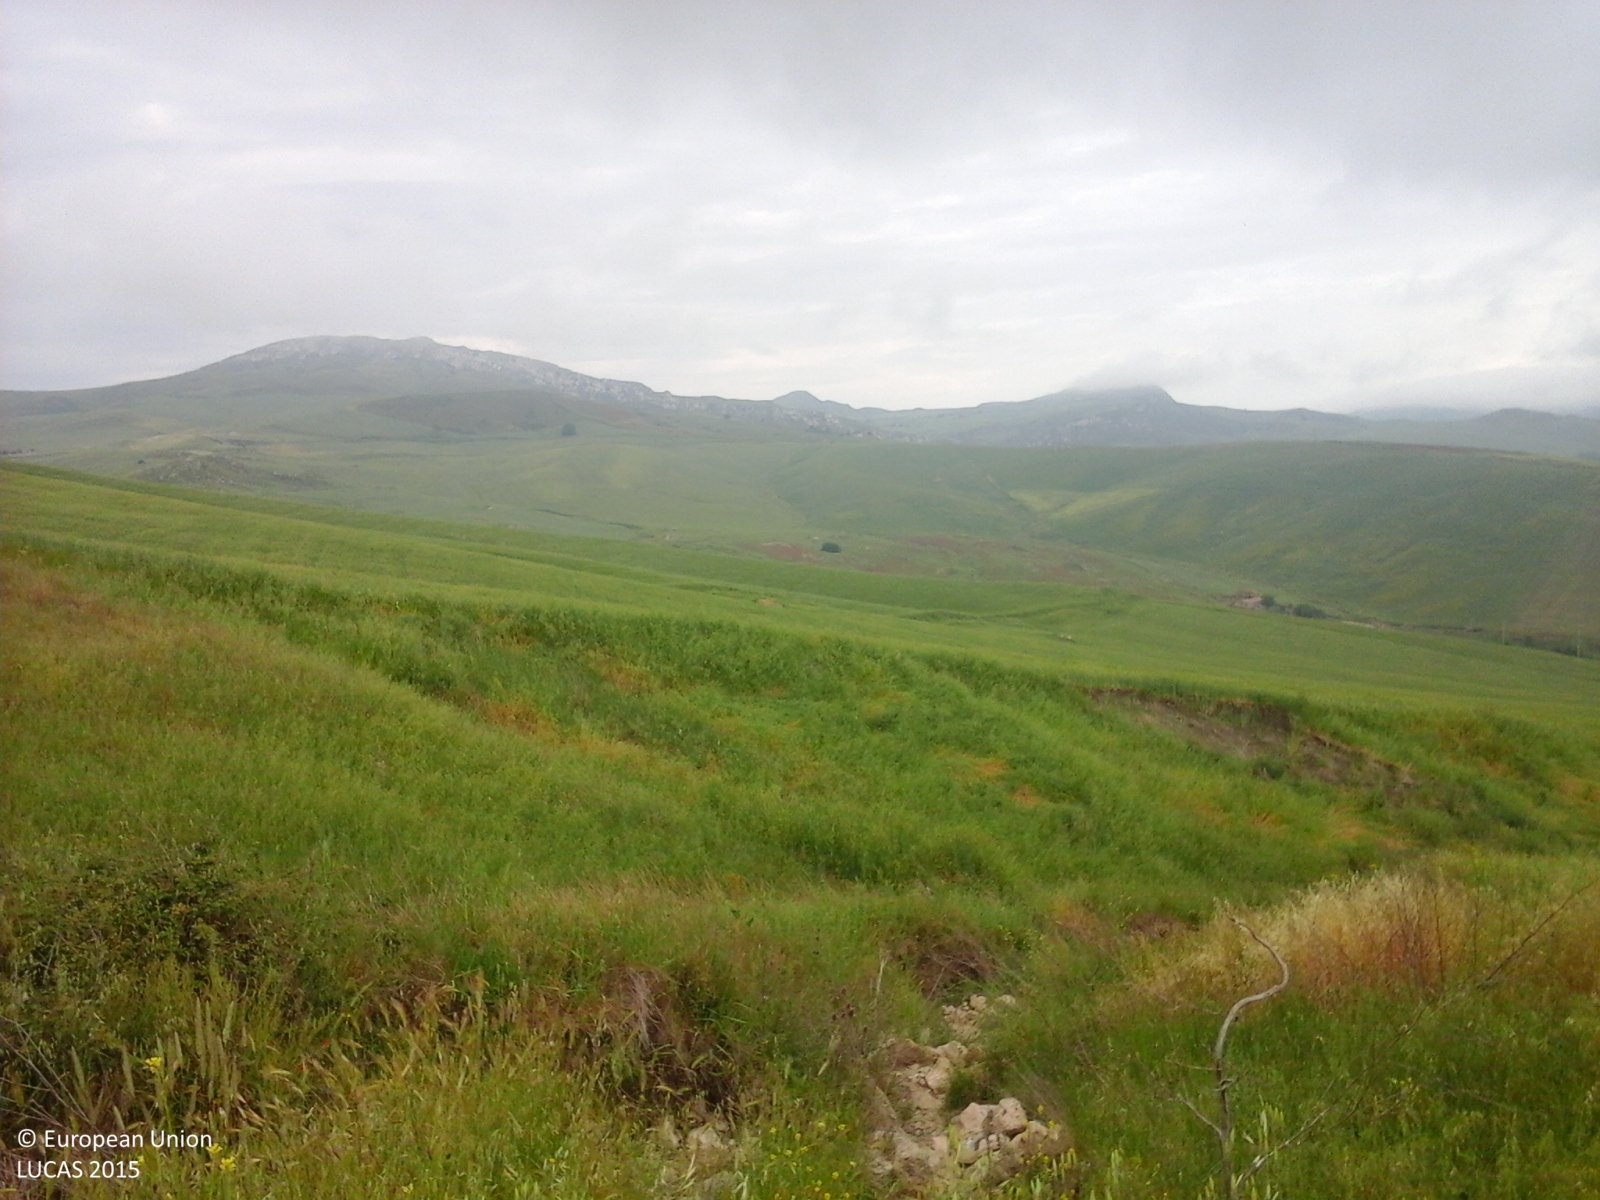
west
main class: Cropland
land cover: Durum wheat
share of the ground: > 75 %
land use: Agriculture (excluding fallow land and kitchen gardens)
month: May
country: IT
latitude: 37.7371
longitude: 13.9769
